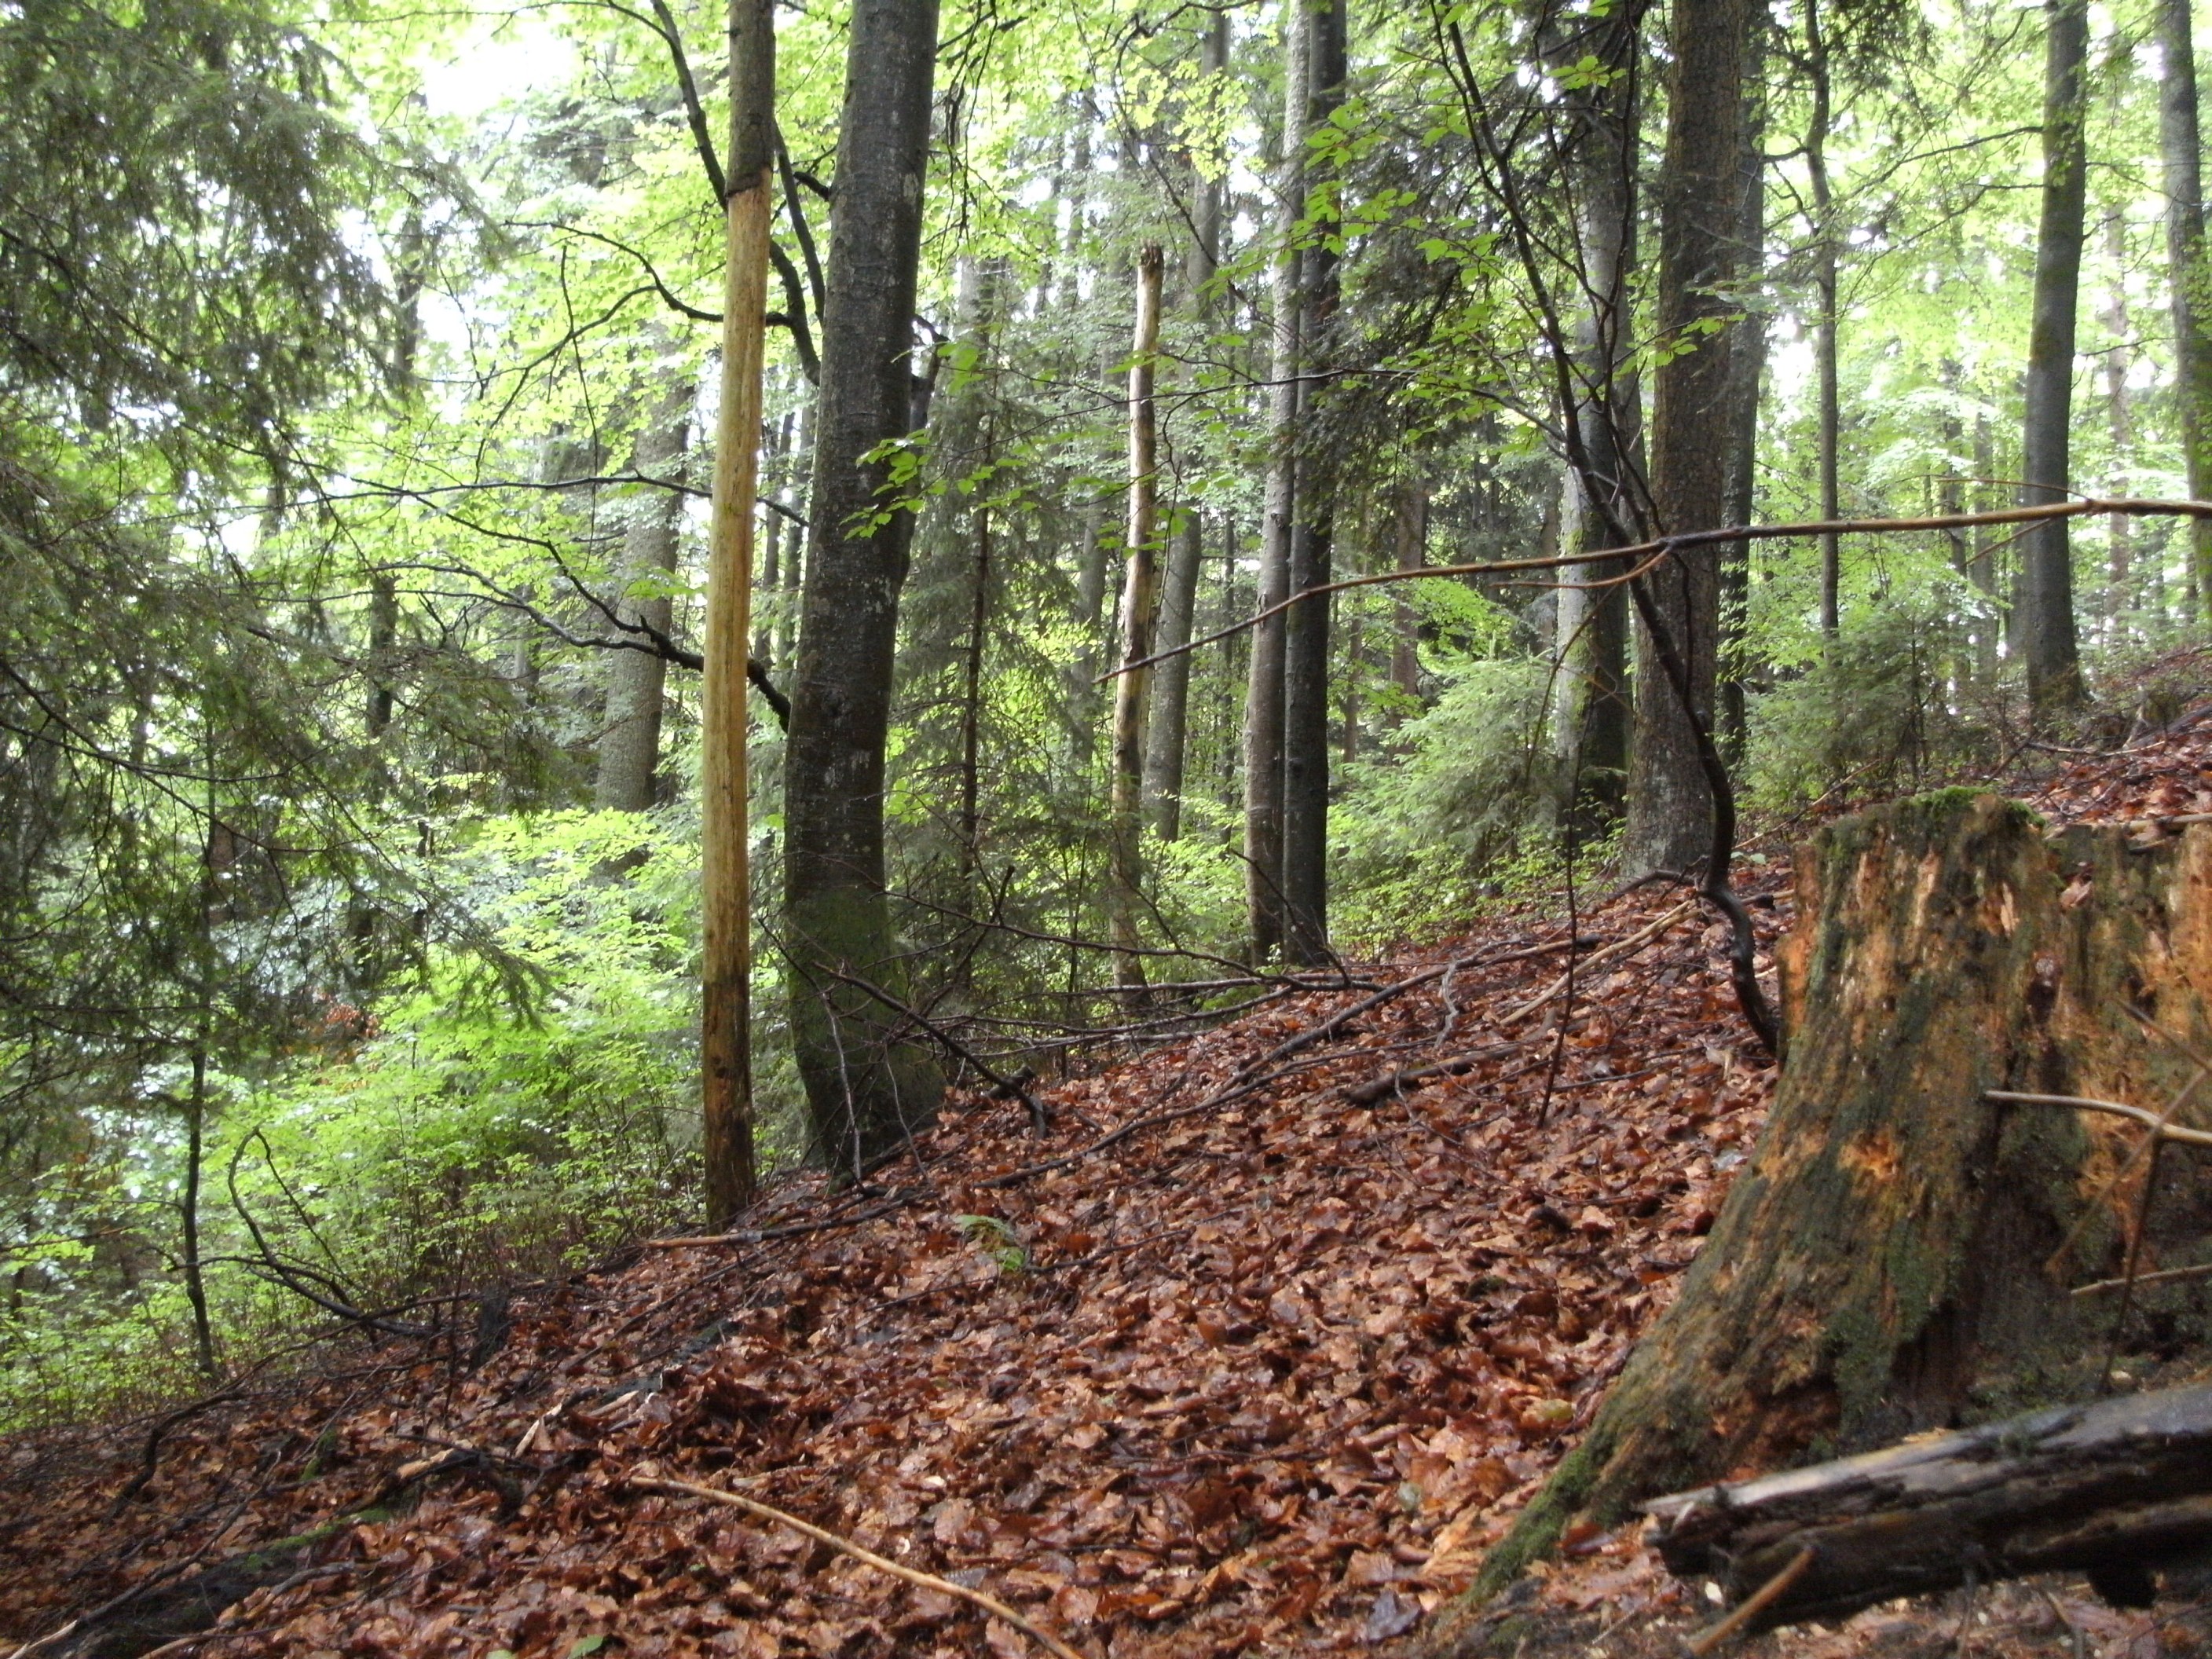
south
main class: Woodland
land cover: Spruce dominated mixed woodland
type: beech forest
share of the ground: > 75 %
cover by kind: coniferous forest trees 50 %, broadleaved forest trees 50 %
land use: Forestry
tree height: > 5 m
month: June
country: AT
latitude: 48.5882
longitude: 13.8638
